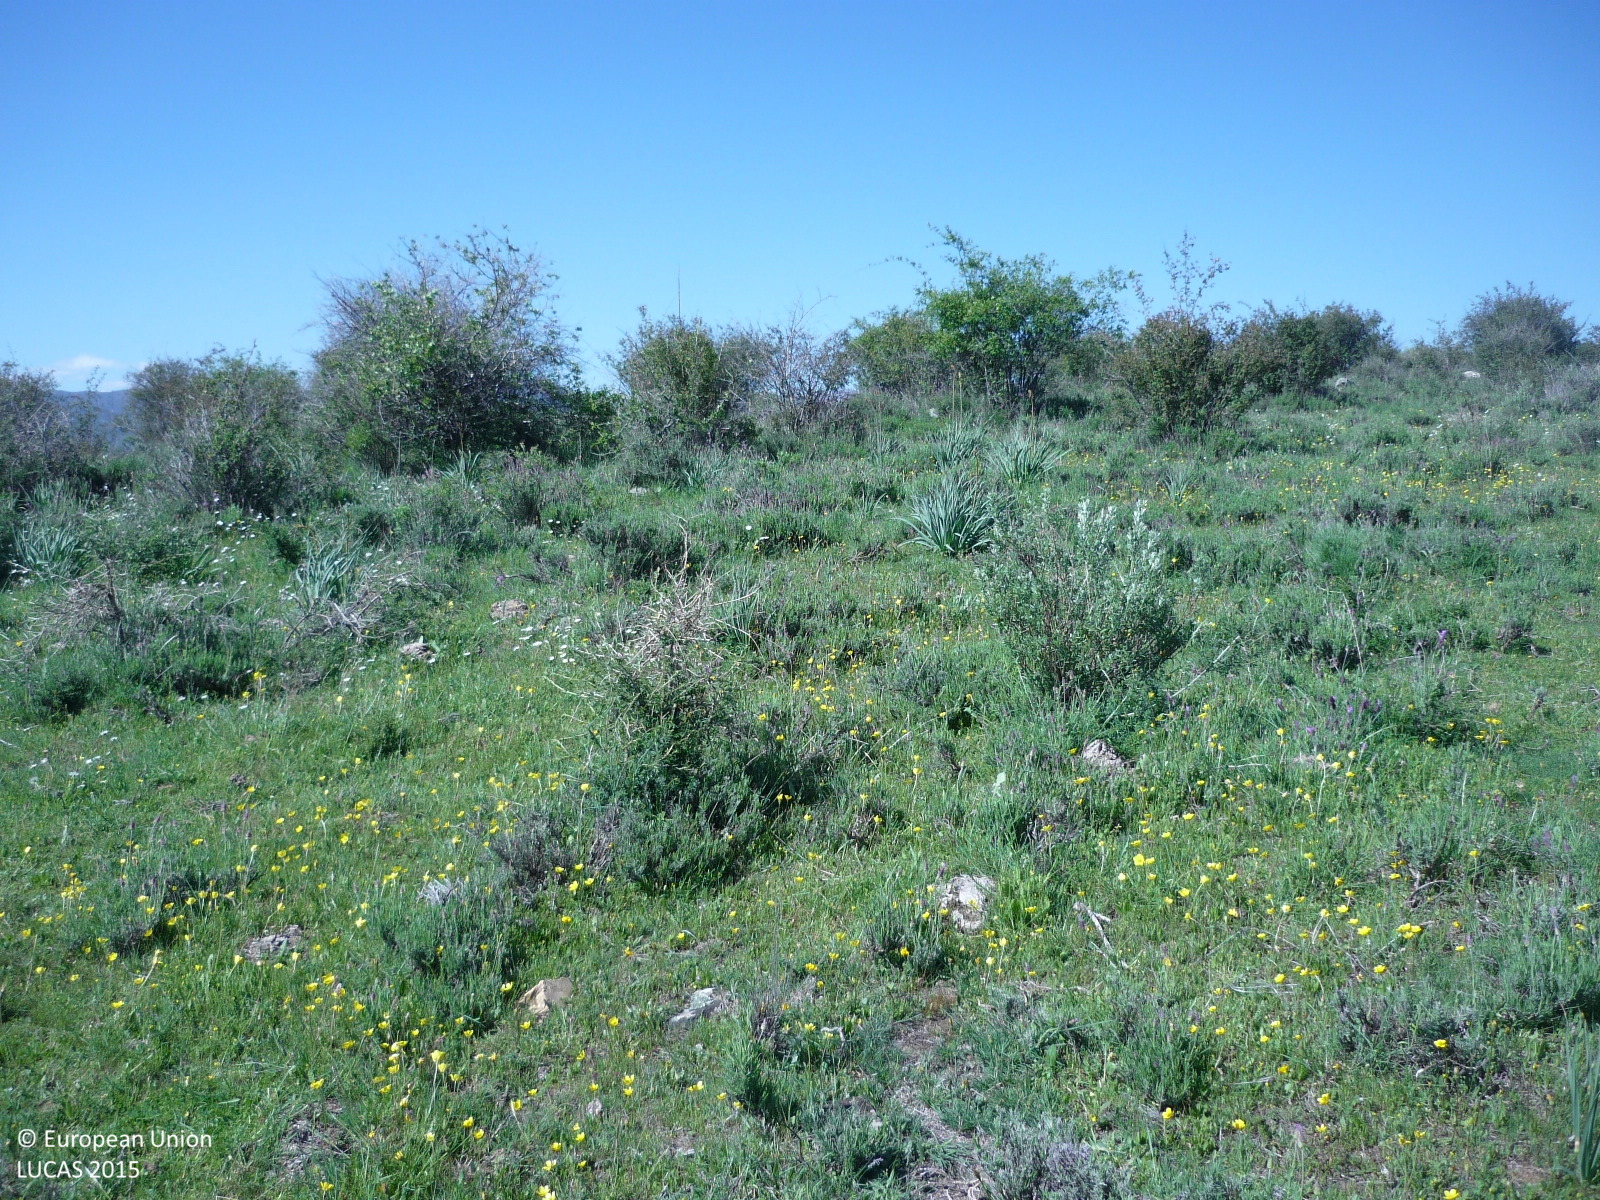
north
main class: Shrubland
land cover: Shrubland without tree cover
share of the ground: 50 - 75 %
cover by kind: shrubs 70 %, unconsolidated bare surface 30 %
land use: Semi-natural and natural areas not in use
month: May
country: ES
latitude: 41.0119
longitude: -3.5146
